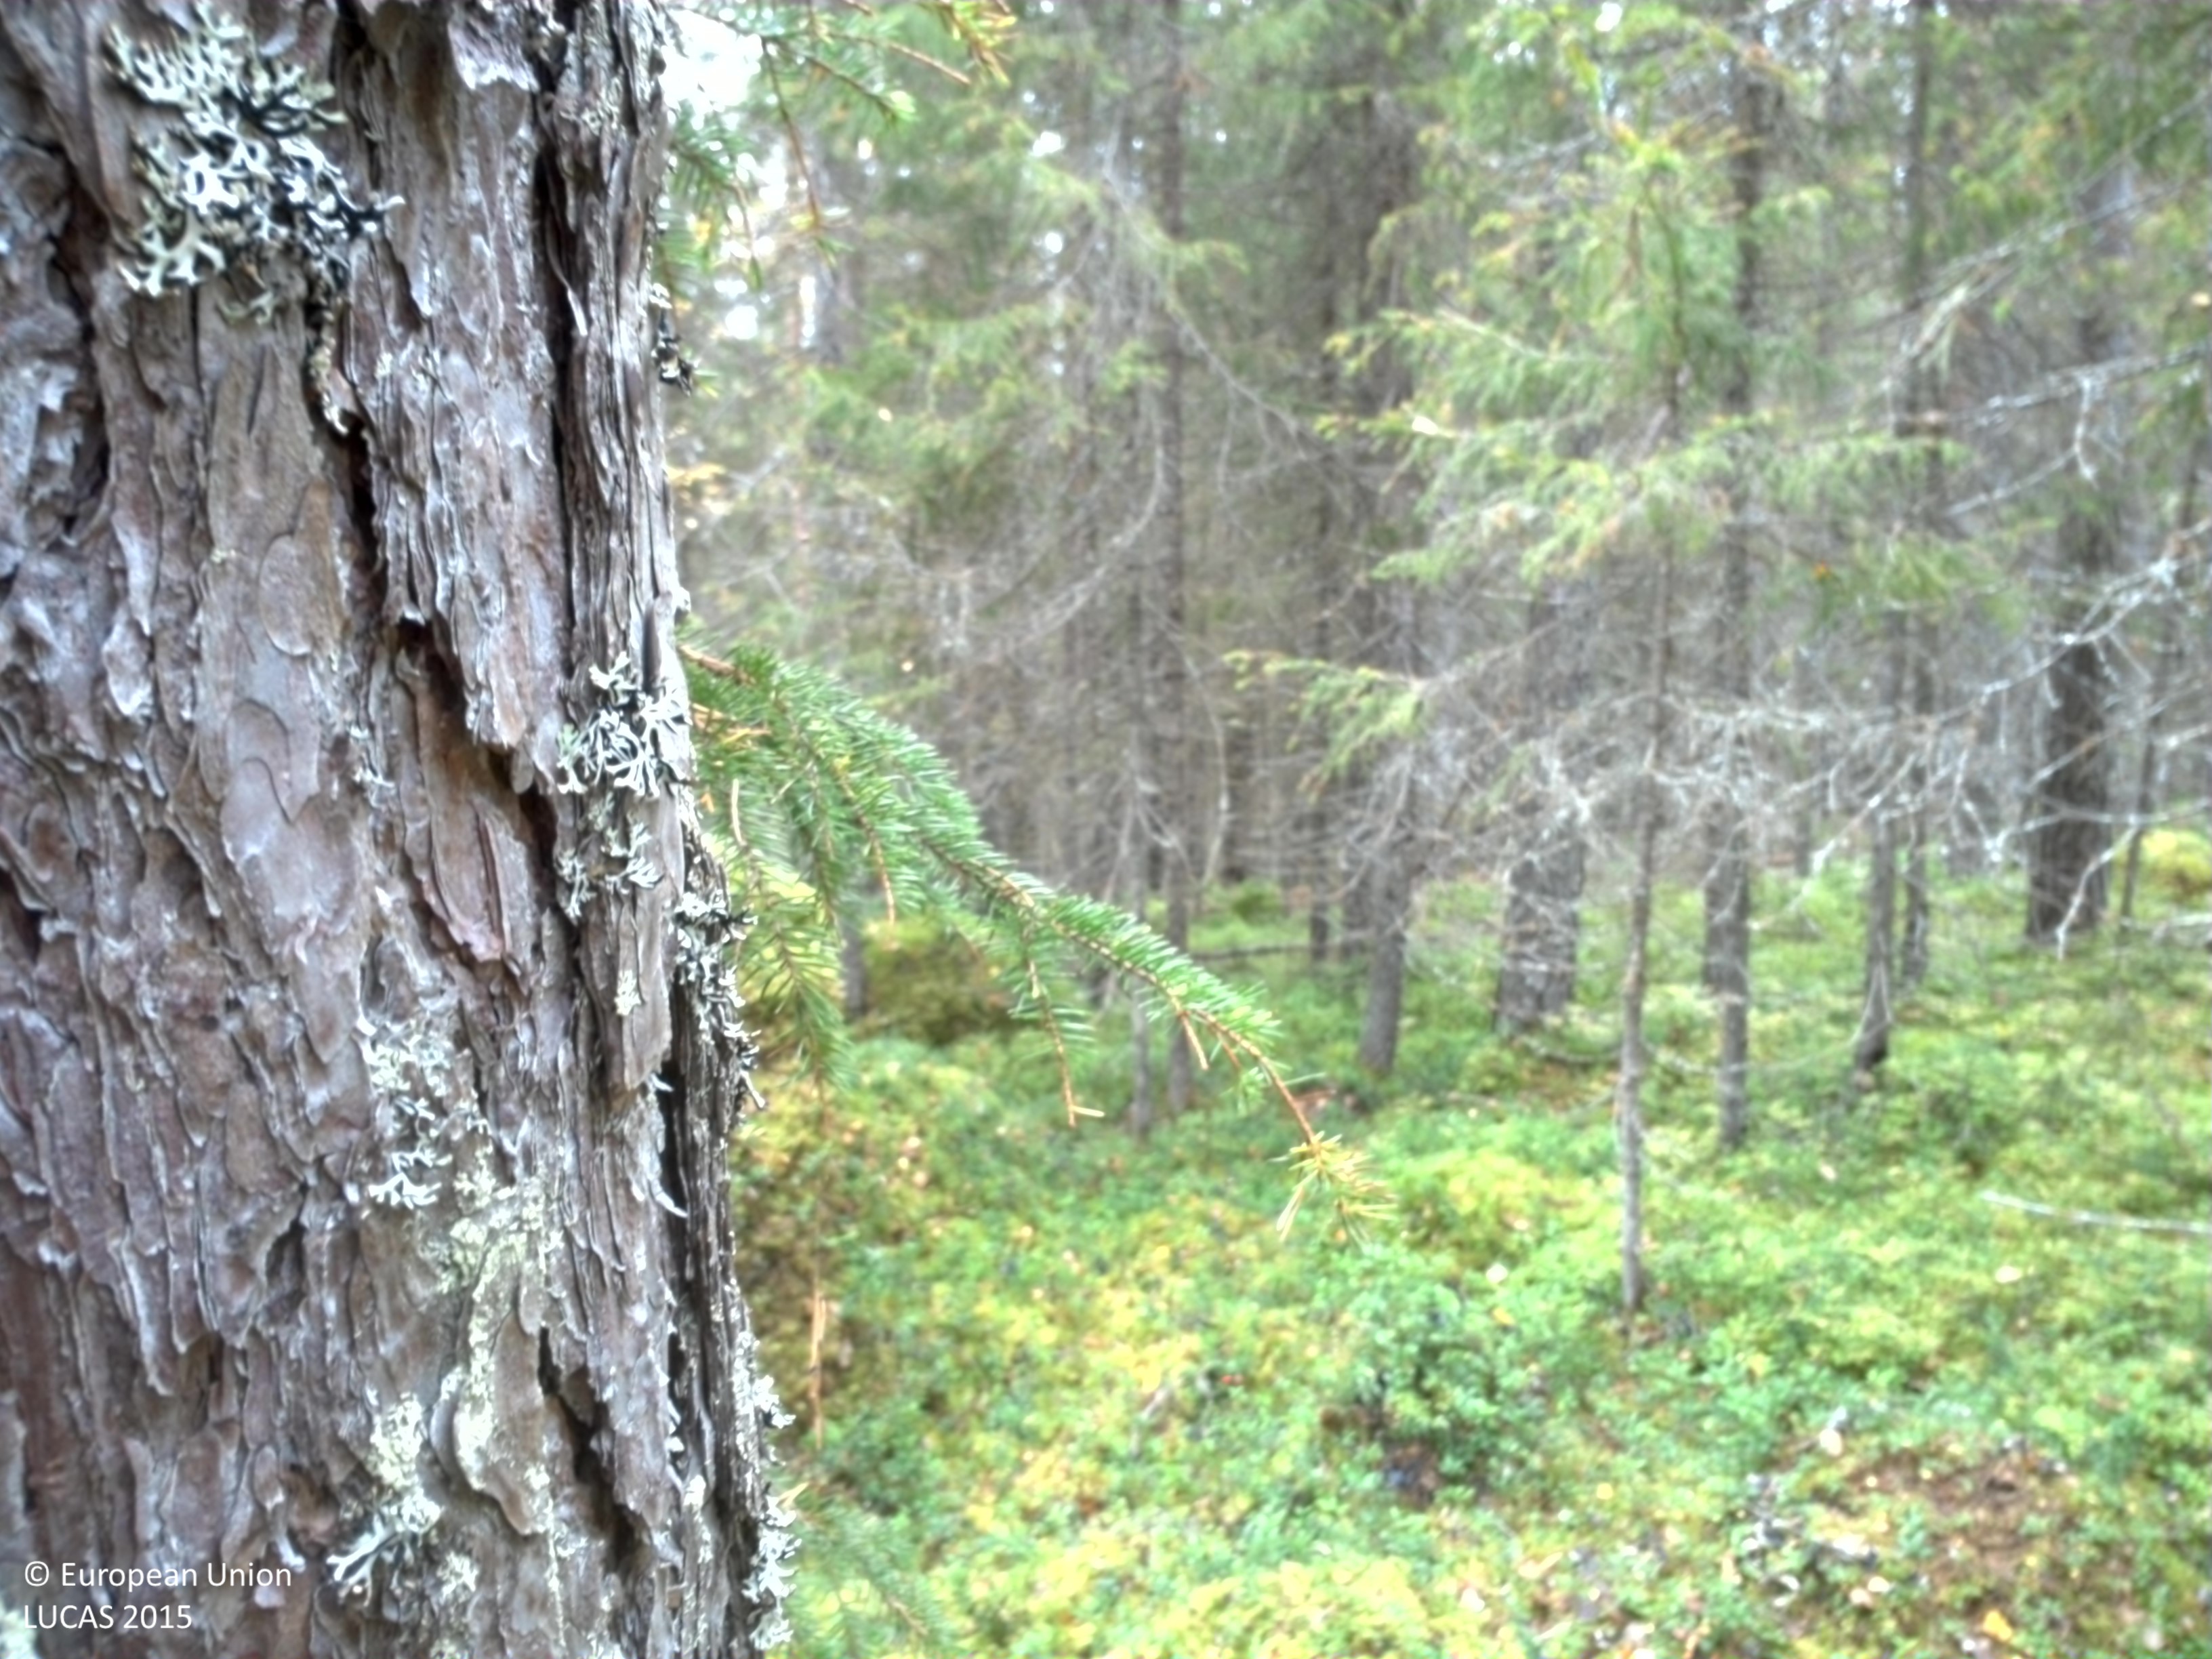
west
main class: Woodland
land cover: Pine dominated coniferous woodland
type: boreal forest
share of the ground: 25 - 50 %
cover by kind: shrubs 65 %, coniferous forest trees 35 %
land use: Forestry
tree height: > 5 m
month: September
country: SE
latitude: 65.8594
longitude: 21.8279
